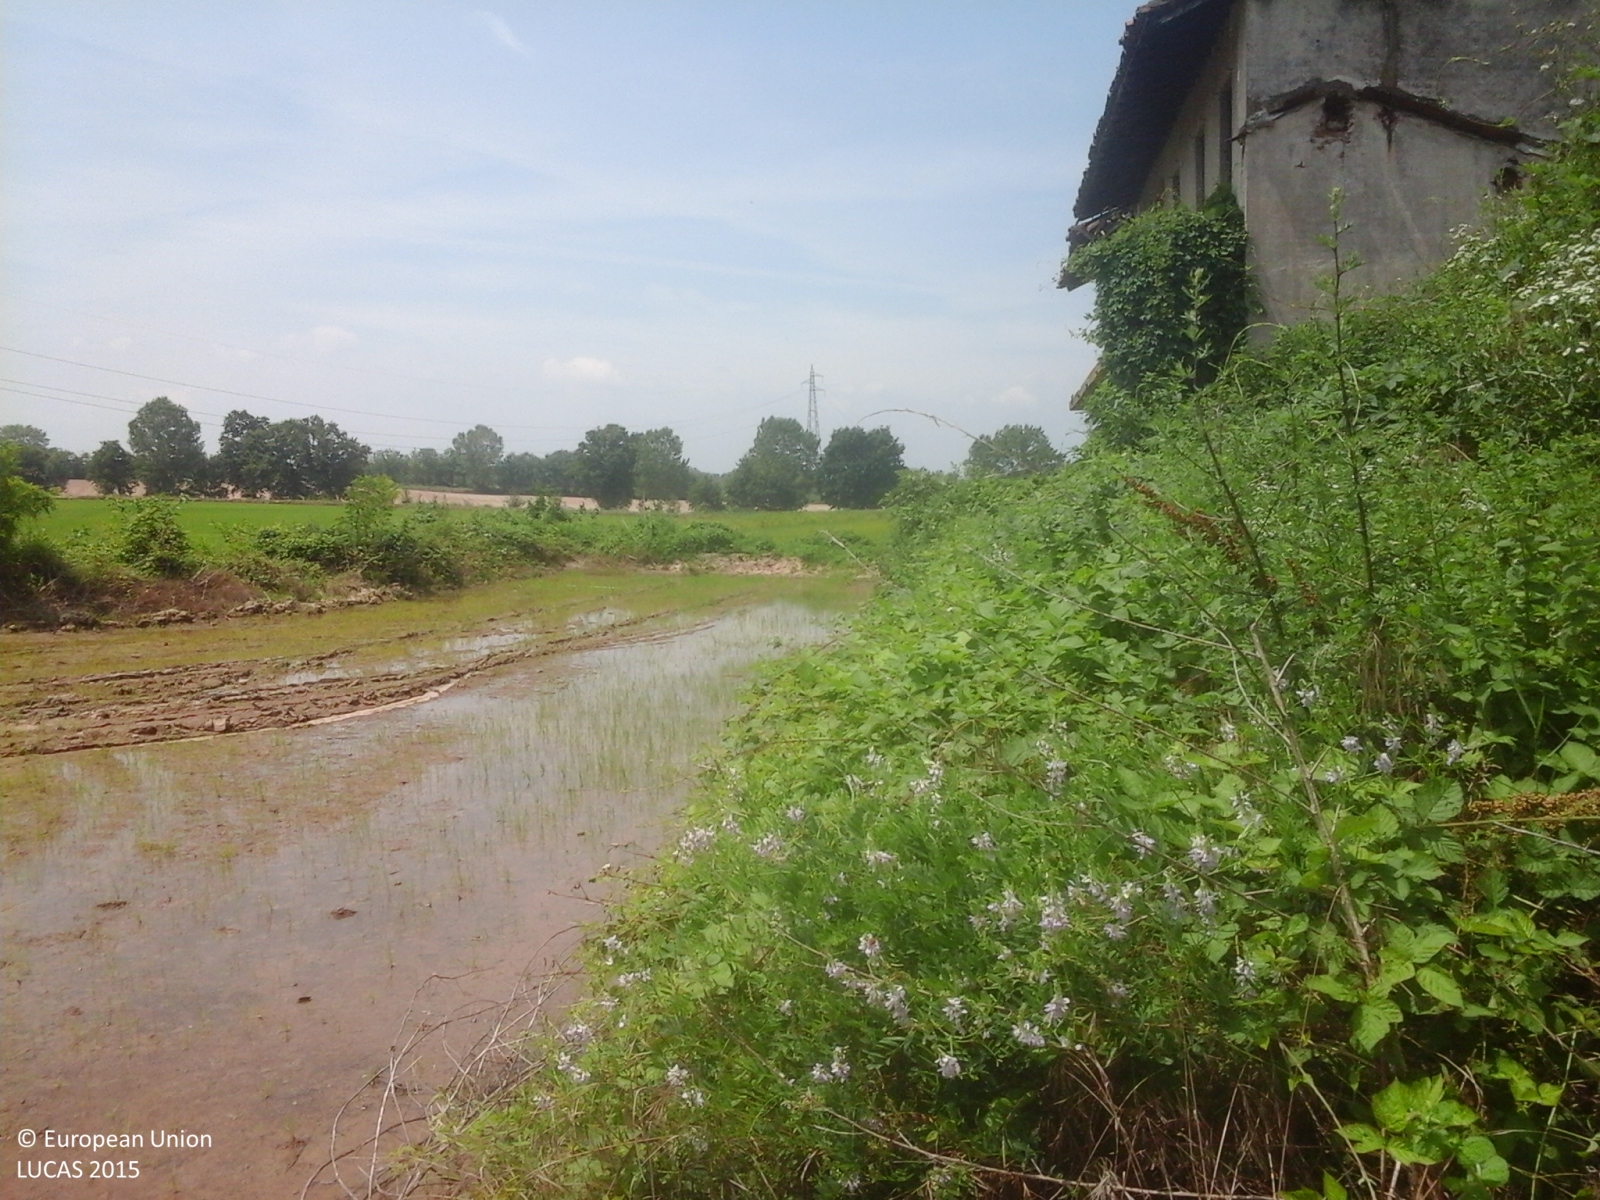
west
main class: Cropland
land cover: Rice
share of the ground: 50 - 75 %
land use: Agriculture (excluding fallow land and kitchen gardens)
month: June
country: IT
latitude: 45.4055
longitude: 8.6353
